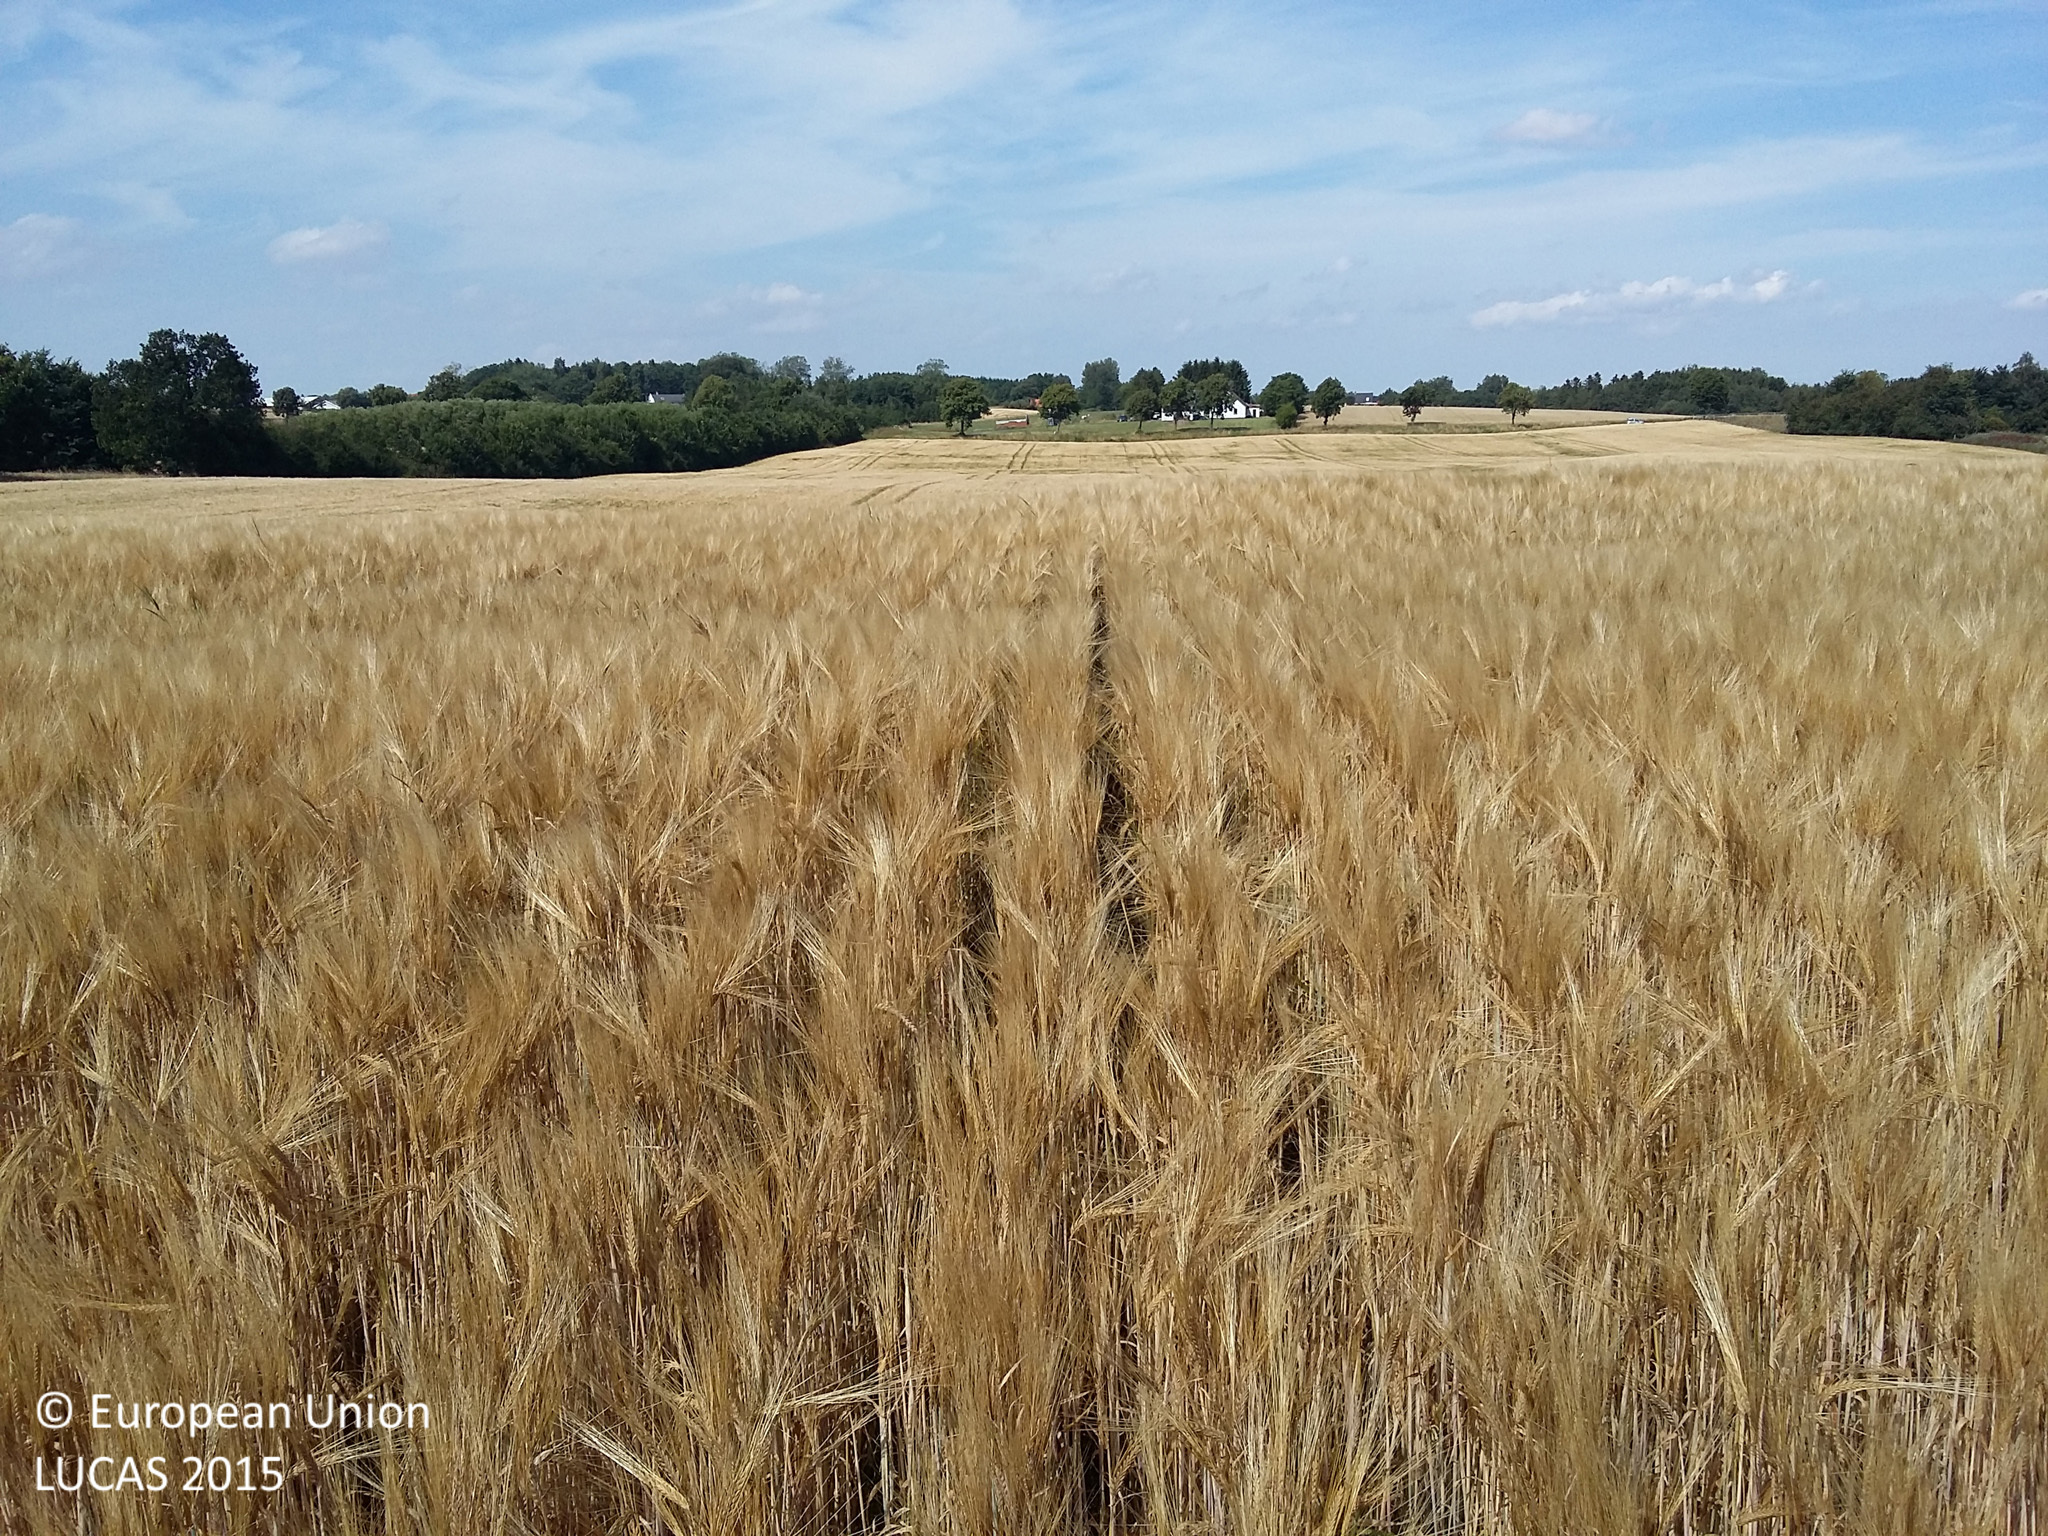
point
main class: Cropland
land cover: Barley
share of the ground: > 75 %
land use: Agriculture (excluding fallow land and kitchen gardens)
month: August
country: DK
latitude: 55.3484
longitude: 11.7806
